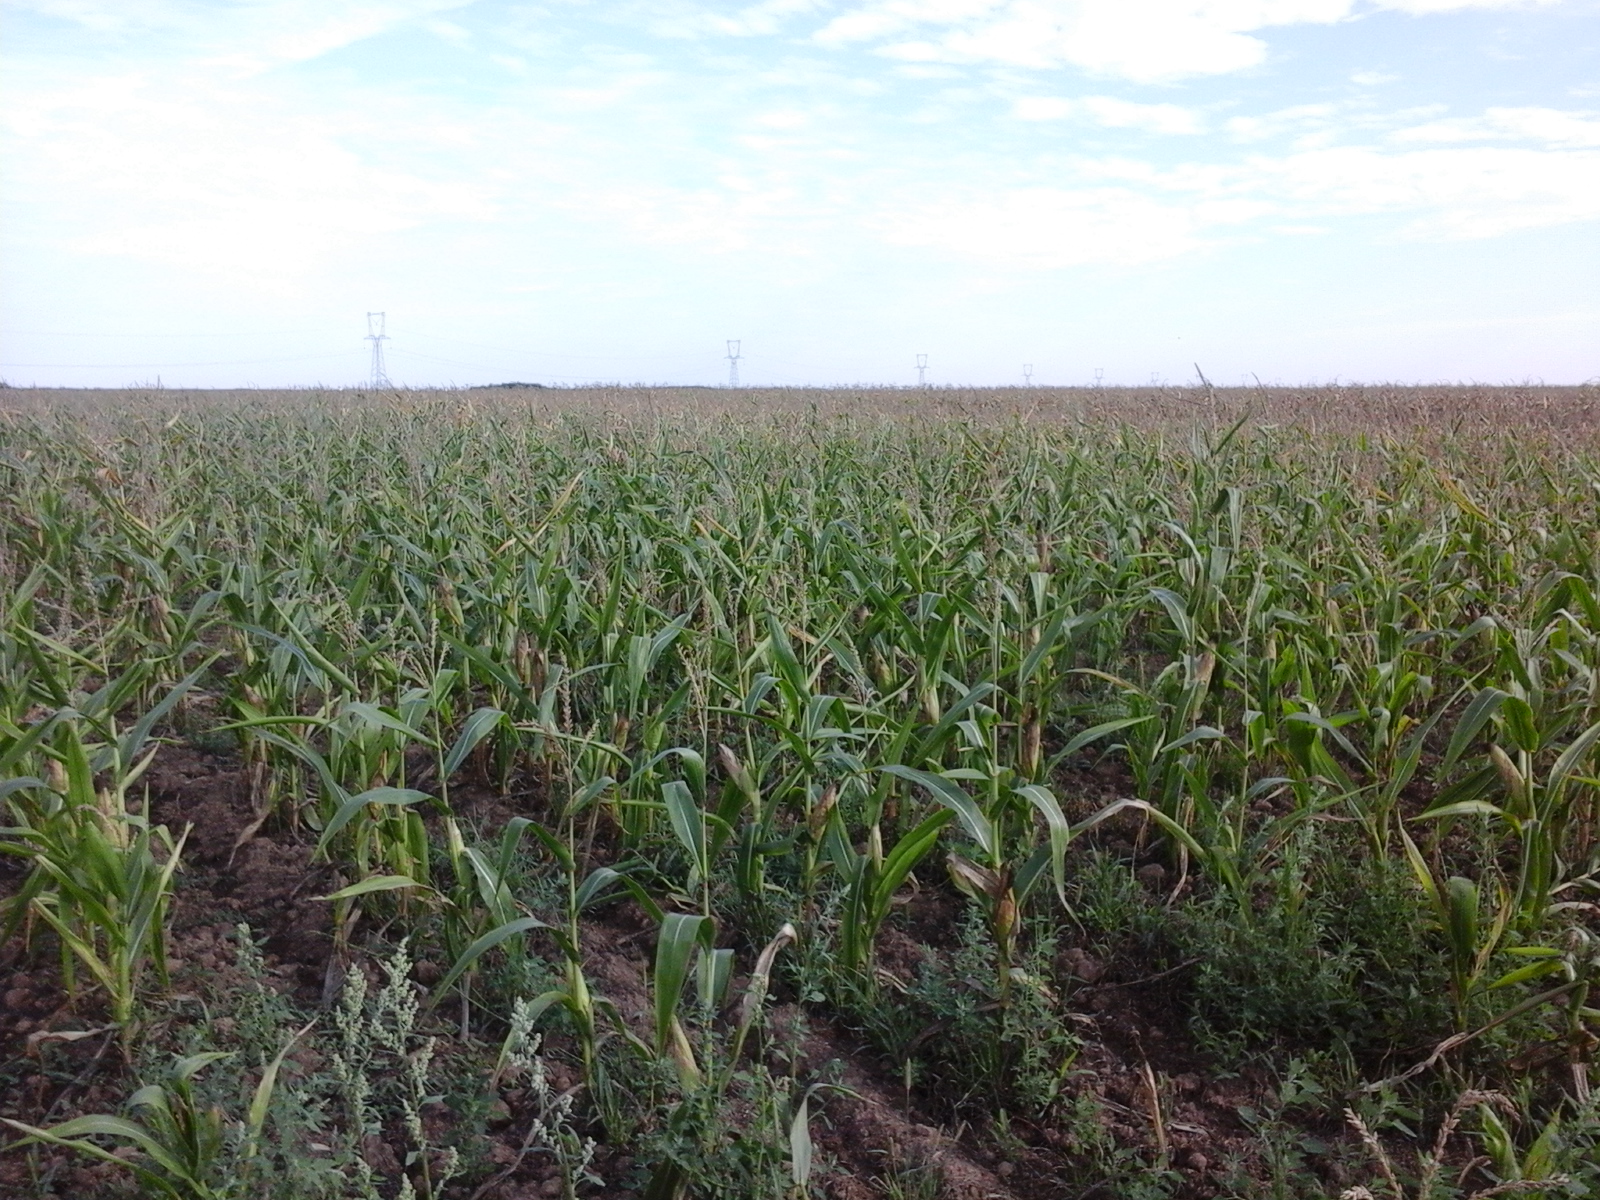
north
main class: Cropland
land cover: Maize
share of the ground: > 75 %
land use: Agriculture (excluding fallow land and kitchen gardens)
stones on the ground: < 10 %
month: August
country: RO
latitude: 46.4702
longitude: 21.5375
